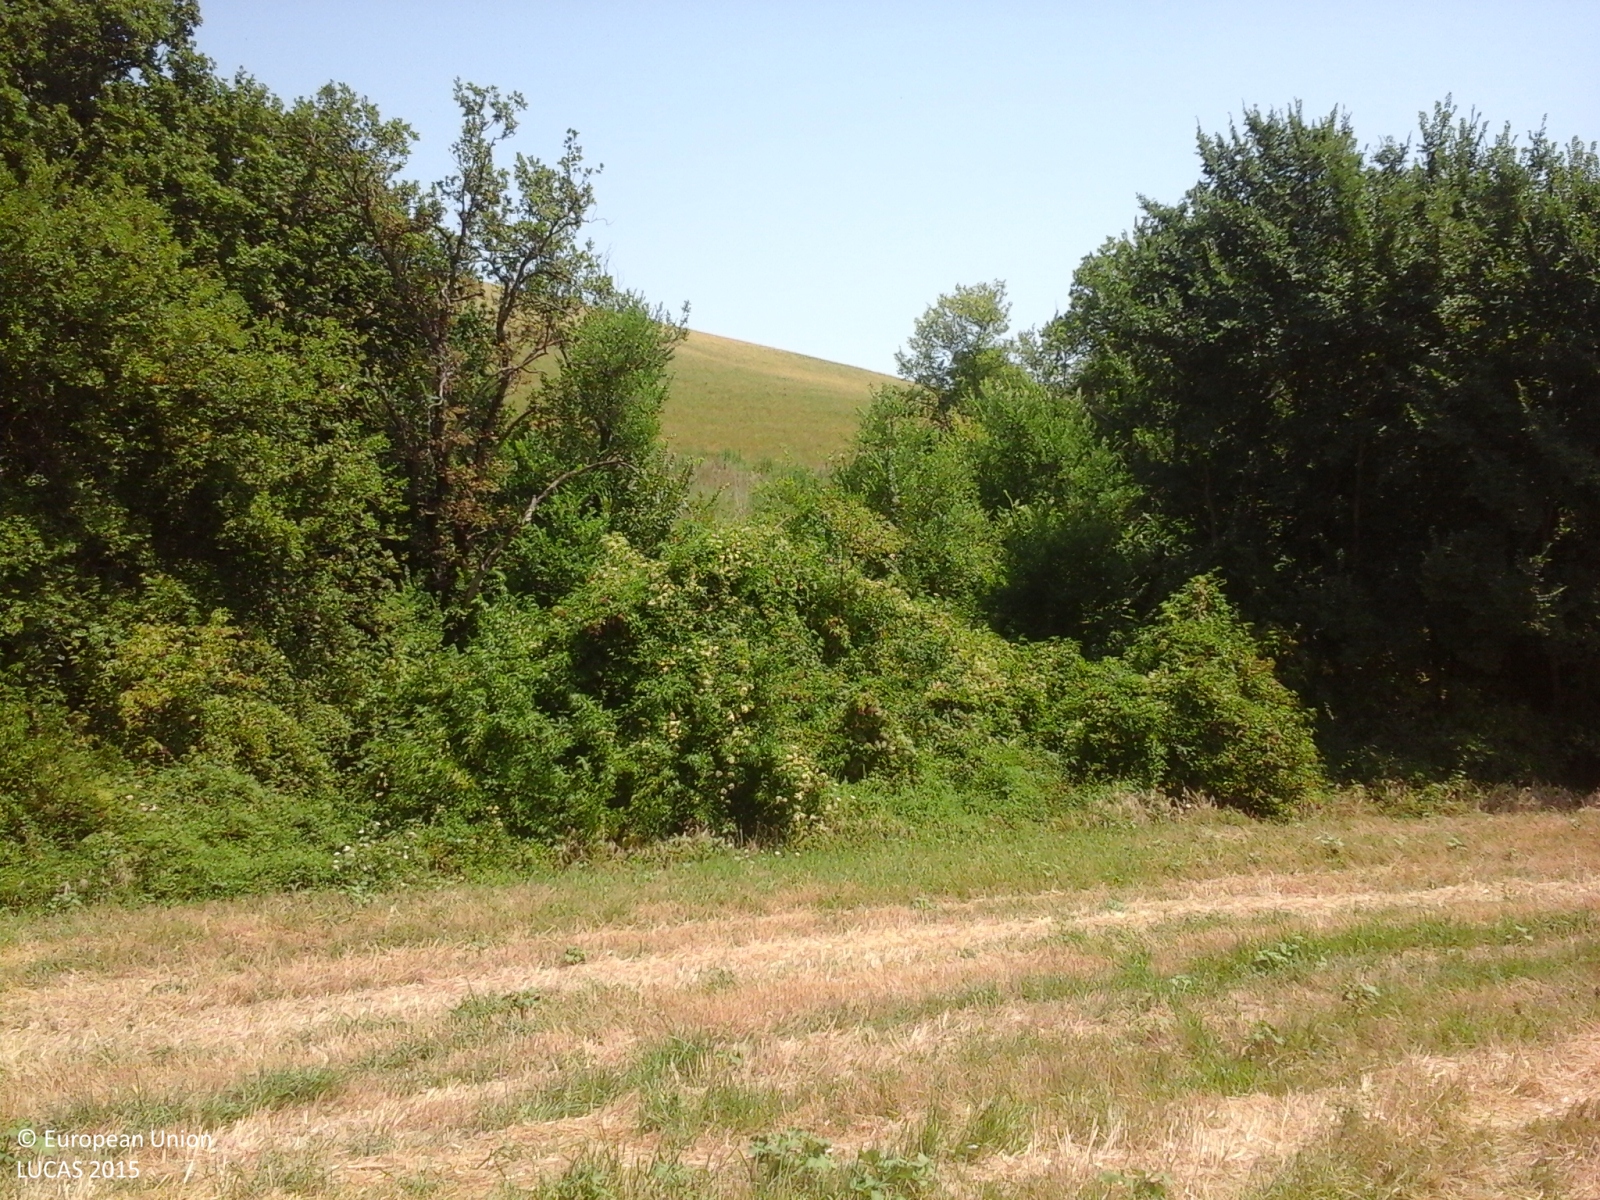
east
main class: Cropland
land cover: Durum wheat
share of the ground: > 75 %
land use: Agriculture (excluding fallow land and kitchen gardens)
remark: Harvested field
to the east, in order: Durum wheat; Broadleaved woodland; Rivers and streams; Broadleaved woodland; Lucerne
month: July
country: IT
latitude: 43.2326
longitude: 13.3035
